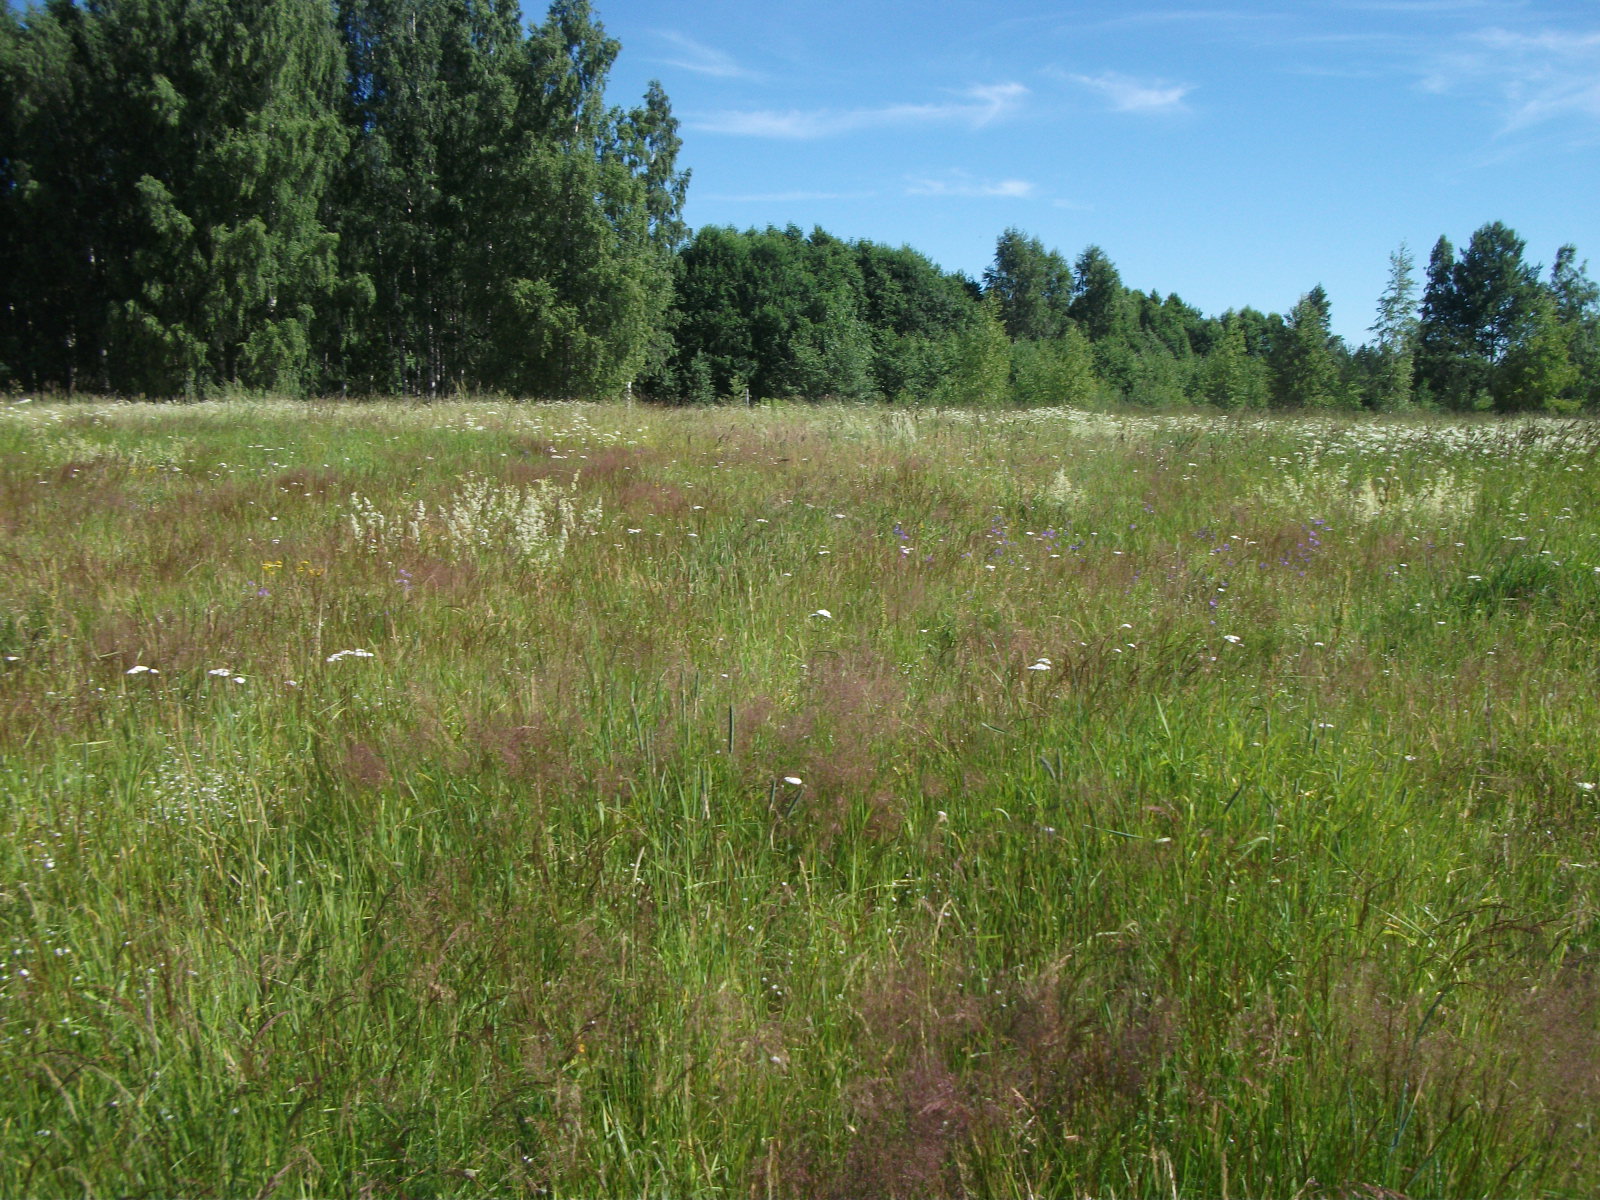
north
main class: Grassland
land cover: Grassland without tree/shrub cover
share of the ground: > 75 %
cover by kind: herbaceous plants 100 %
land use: Agriculture (excluding fallow land and kitchen gardens)
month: July
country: LV
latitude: 56.7156
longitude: 26.1649
